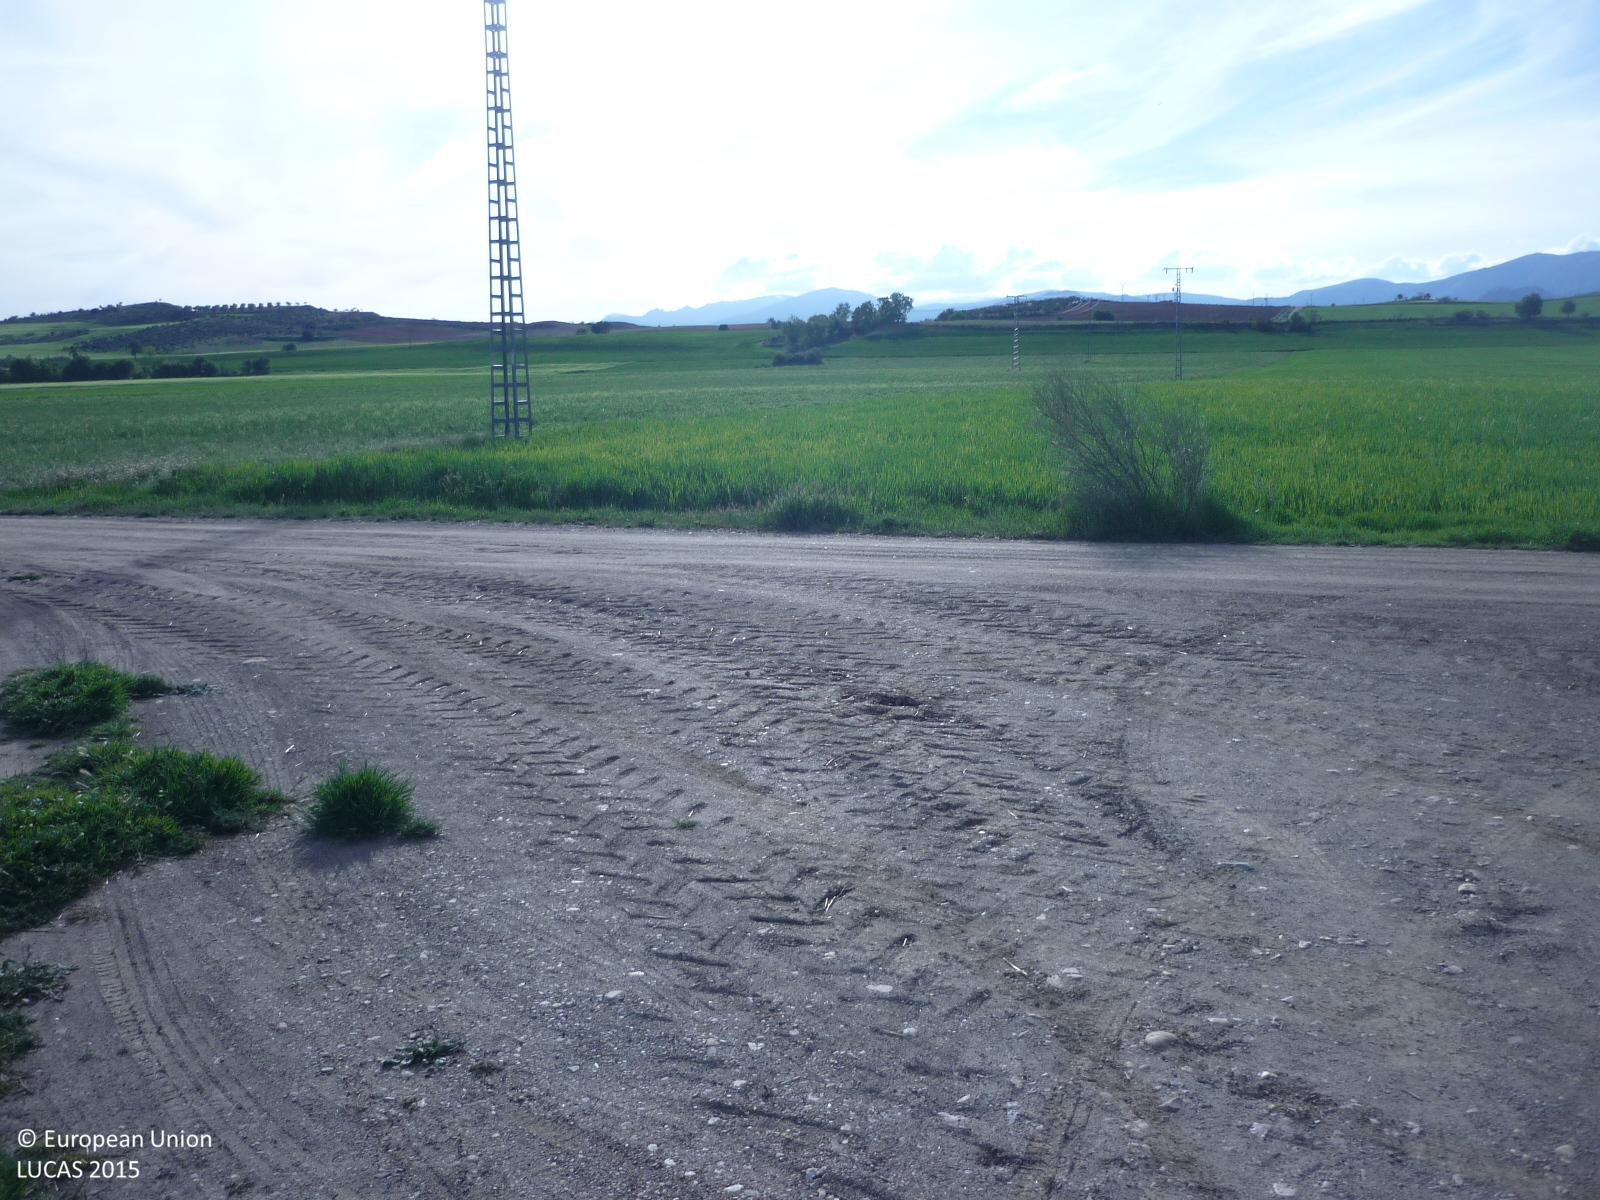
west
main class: Cropland
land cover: Barley
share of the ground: > 75 %
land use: Agriculture (excluding fallow land and kitchen gardens)
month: April
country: ES
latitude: 40.8133
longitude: -3.4953
